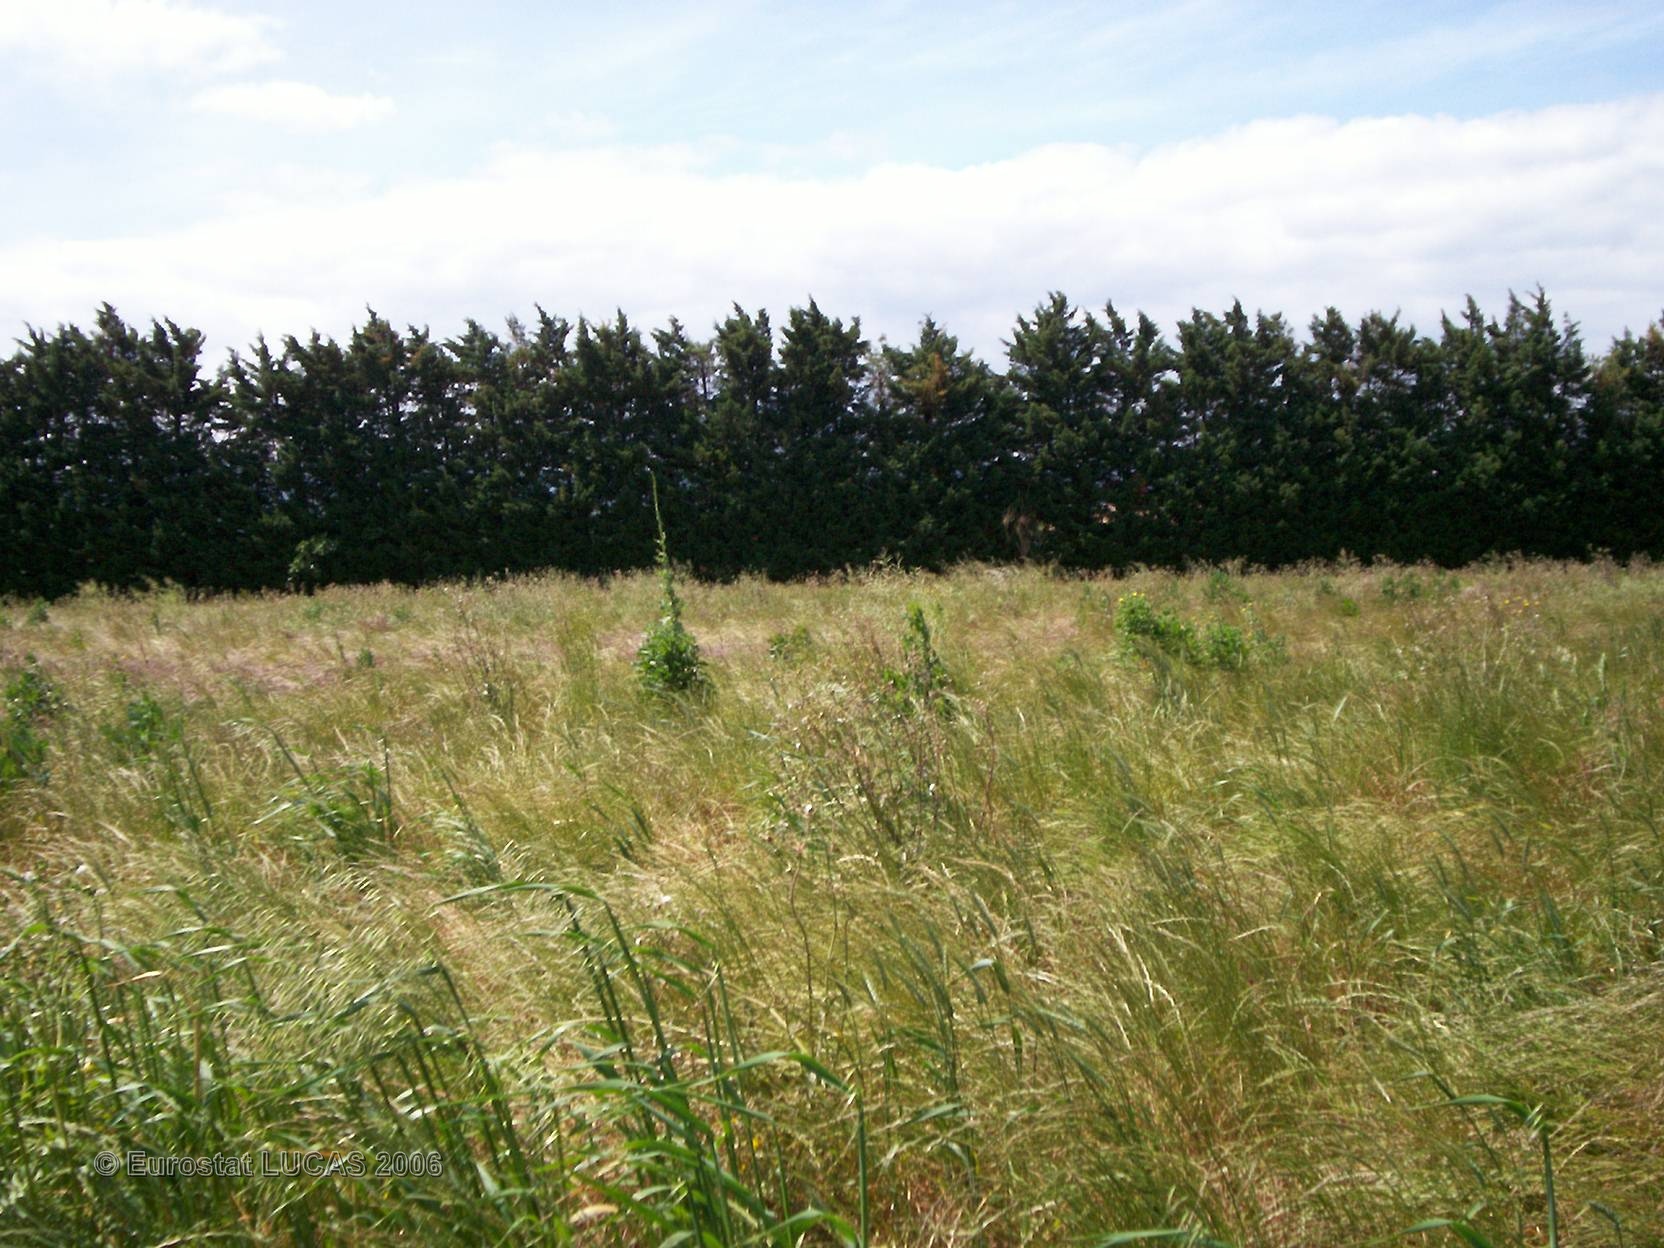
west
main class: Grassland
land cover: Grassland without tree/shrub cover
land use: Fallow land
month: June
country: FR
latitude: 44.8937
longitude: 4.9029
